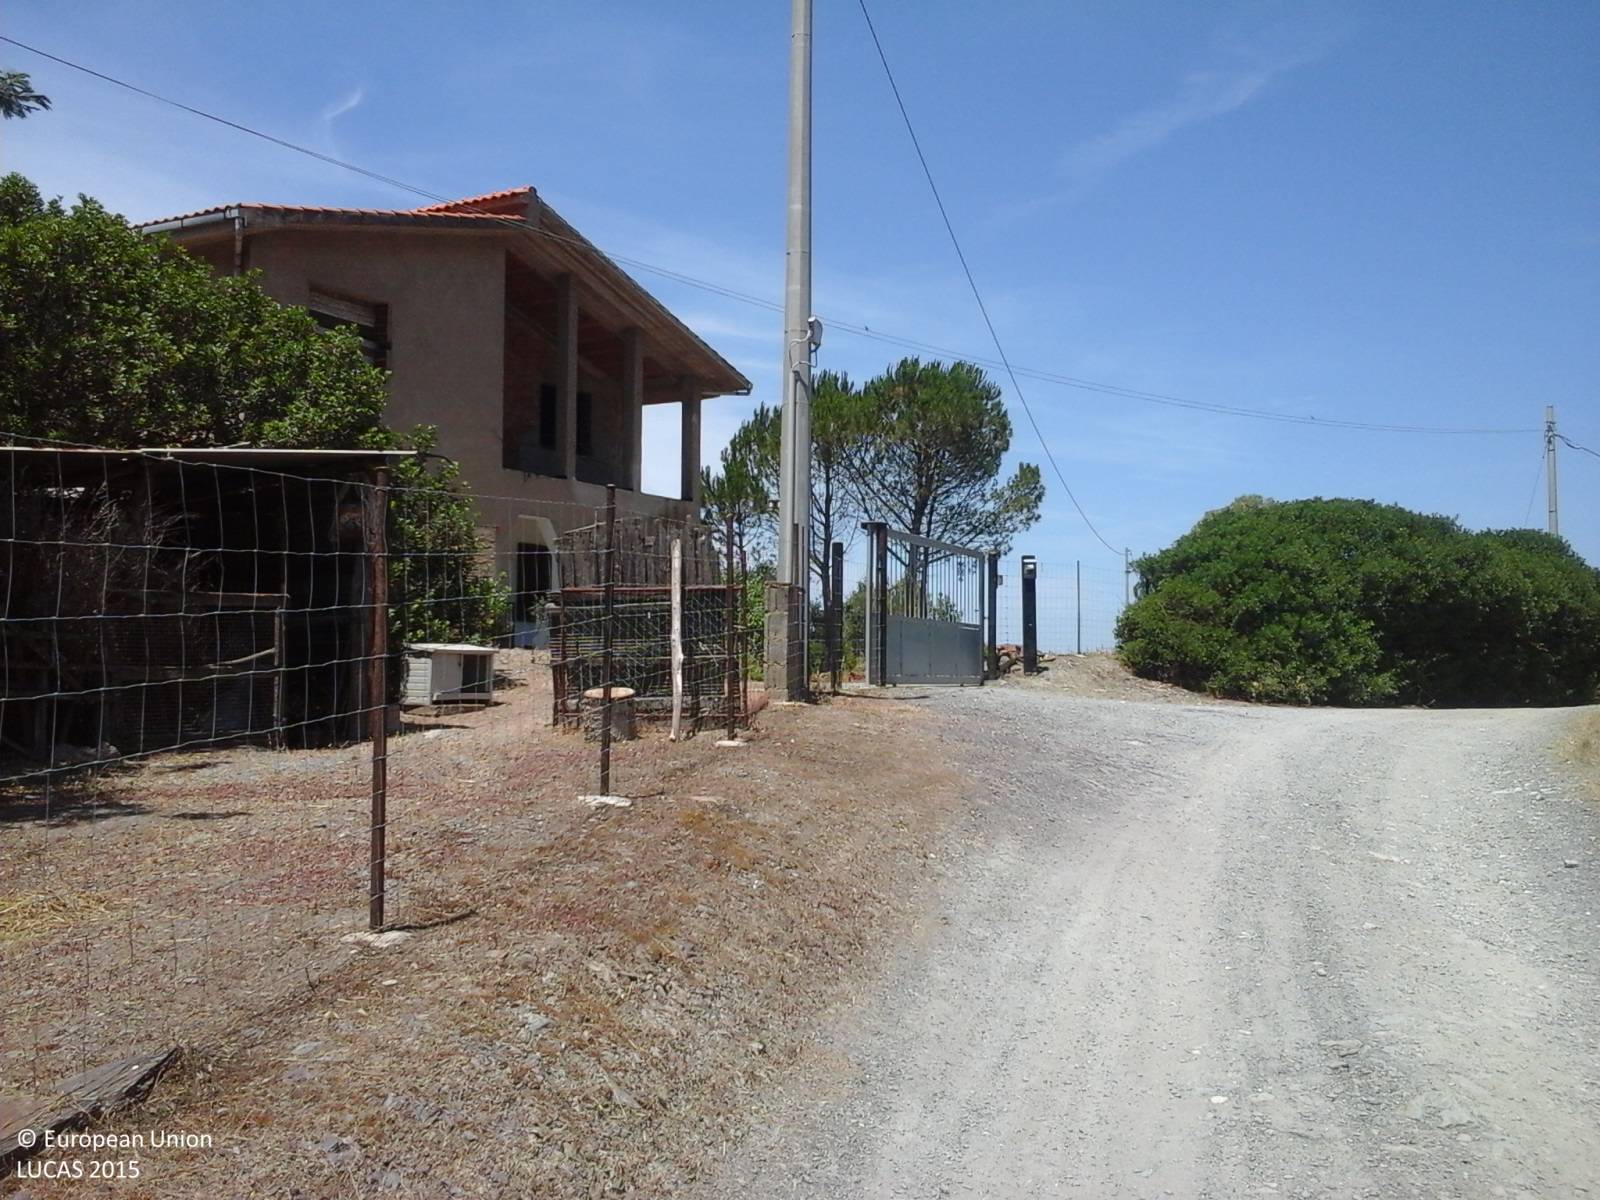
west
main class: Woodland
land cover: Other mixed woodland
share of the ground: 25 - 50 %
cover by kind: herbaceous plants 50 %, broadleaved forest trees 25 %, coniferous forest trees 10 %, unconsolidated bare surface 10 %, shrubs 5 %
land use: Residential
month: June
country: IT
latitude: 39.2242
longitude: 8.5610
